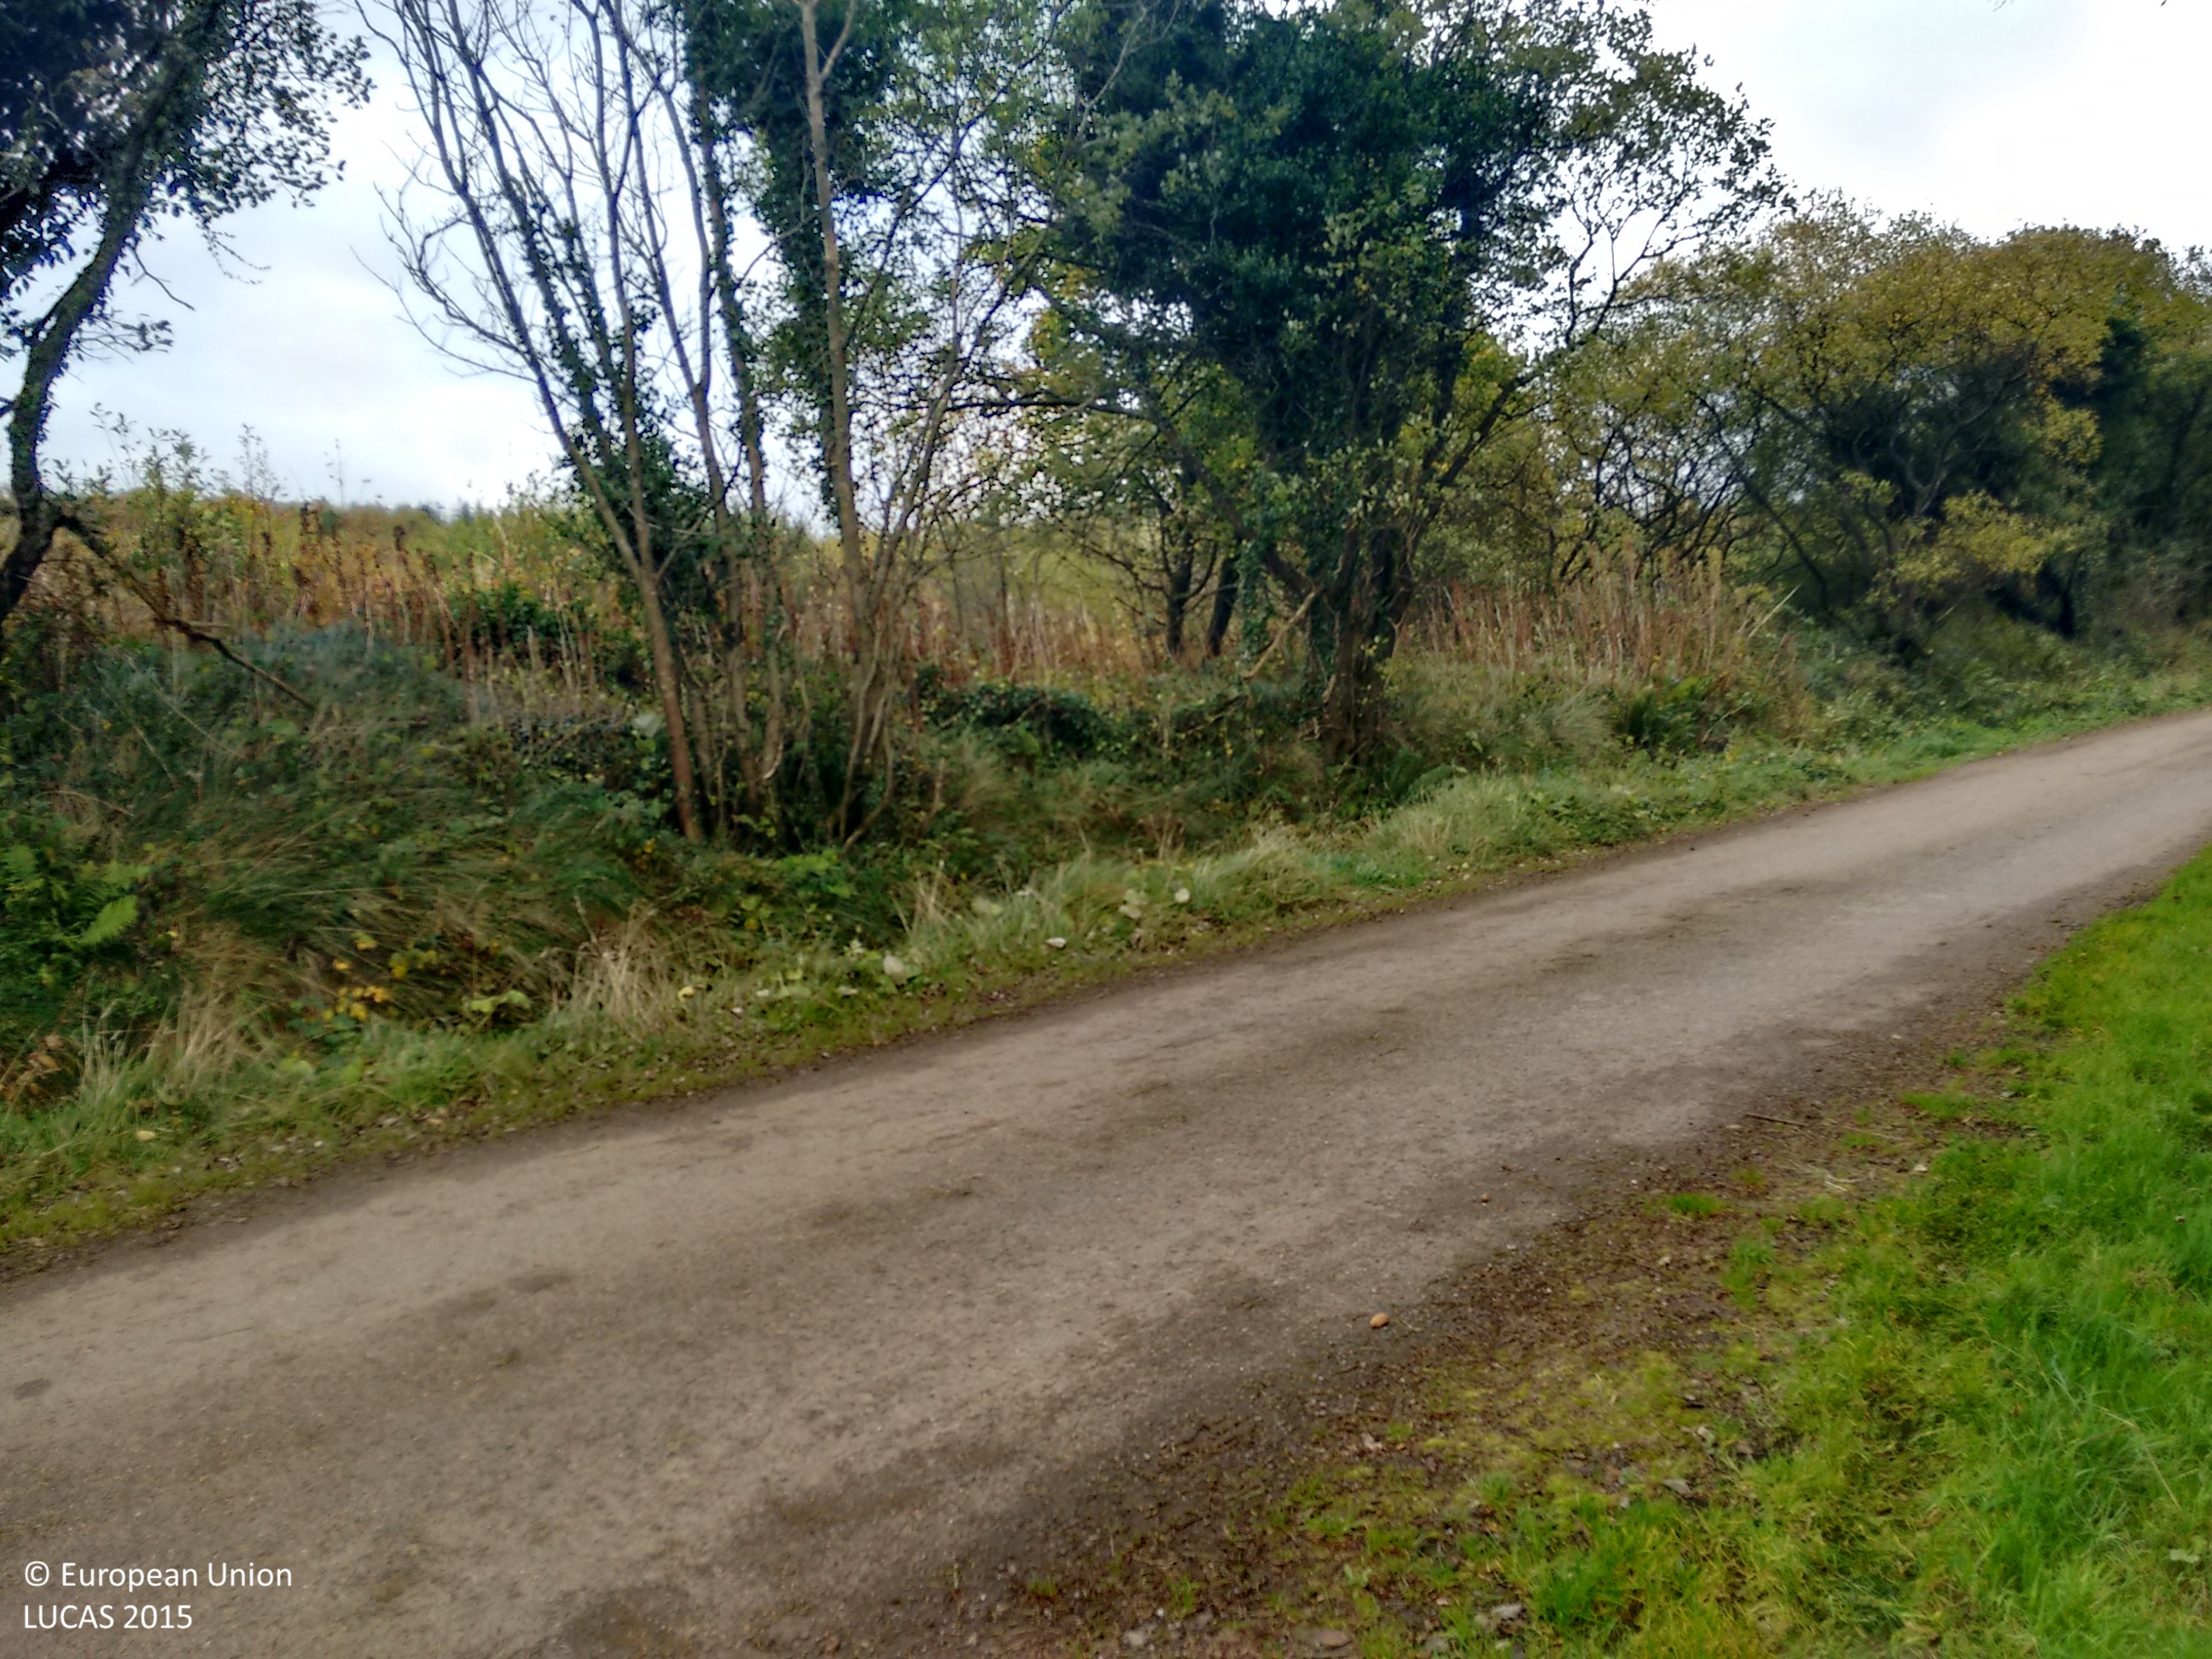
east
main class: Grassland
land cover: Grassland without tree/shrub cover
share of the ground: > 75 %
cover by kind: herbaceous plants 100 %
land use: Agriculture (excluding fallow land and kitchen gardens)
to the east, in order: Grassland without tree/shrub cover; Electric lines; Grassland without tree/shrub cover; Spruce dominated coniferous woodland; Grass margins; Paved roads, cycling and walking lanes; Grass margins; Ditches and canals; Fences; Broadleaved woodland; Other mixed woodland
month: October
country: IE
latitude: 52.9992
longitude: -7.7339
